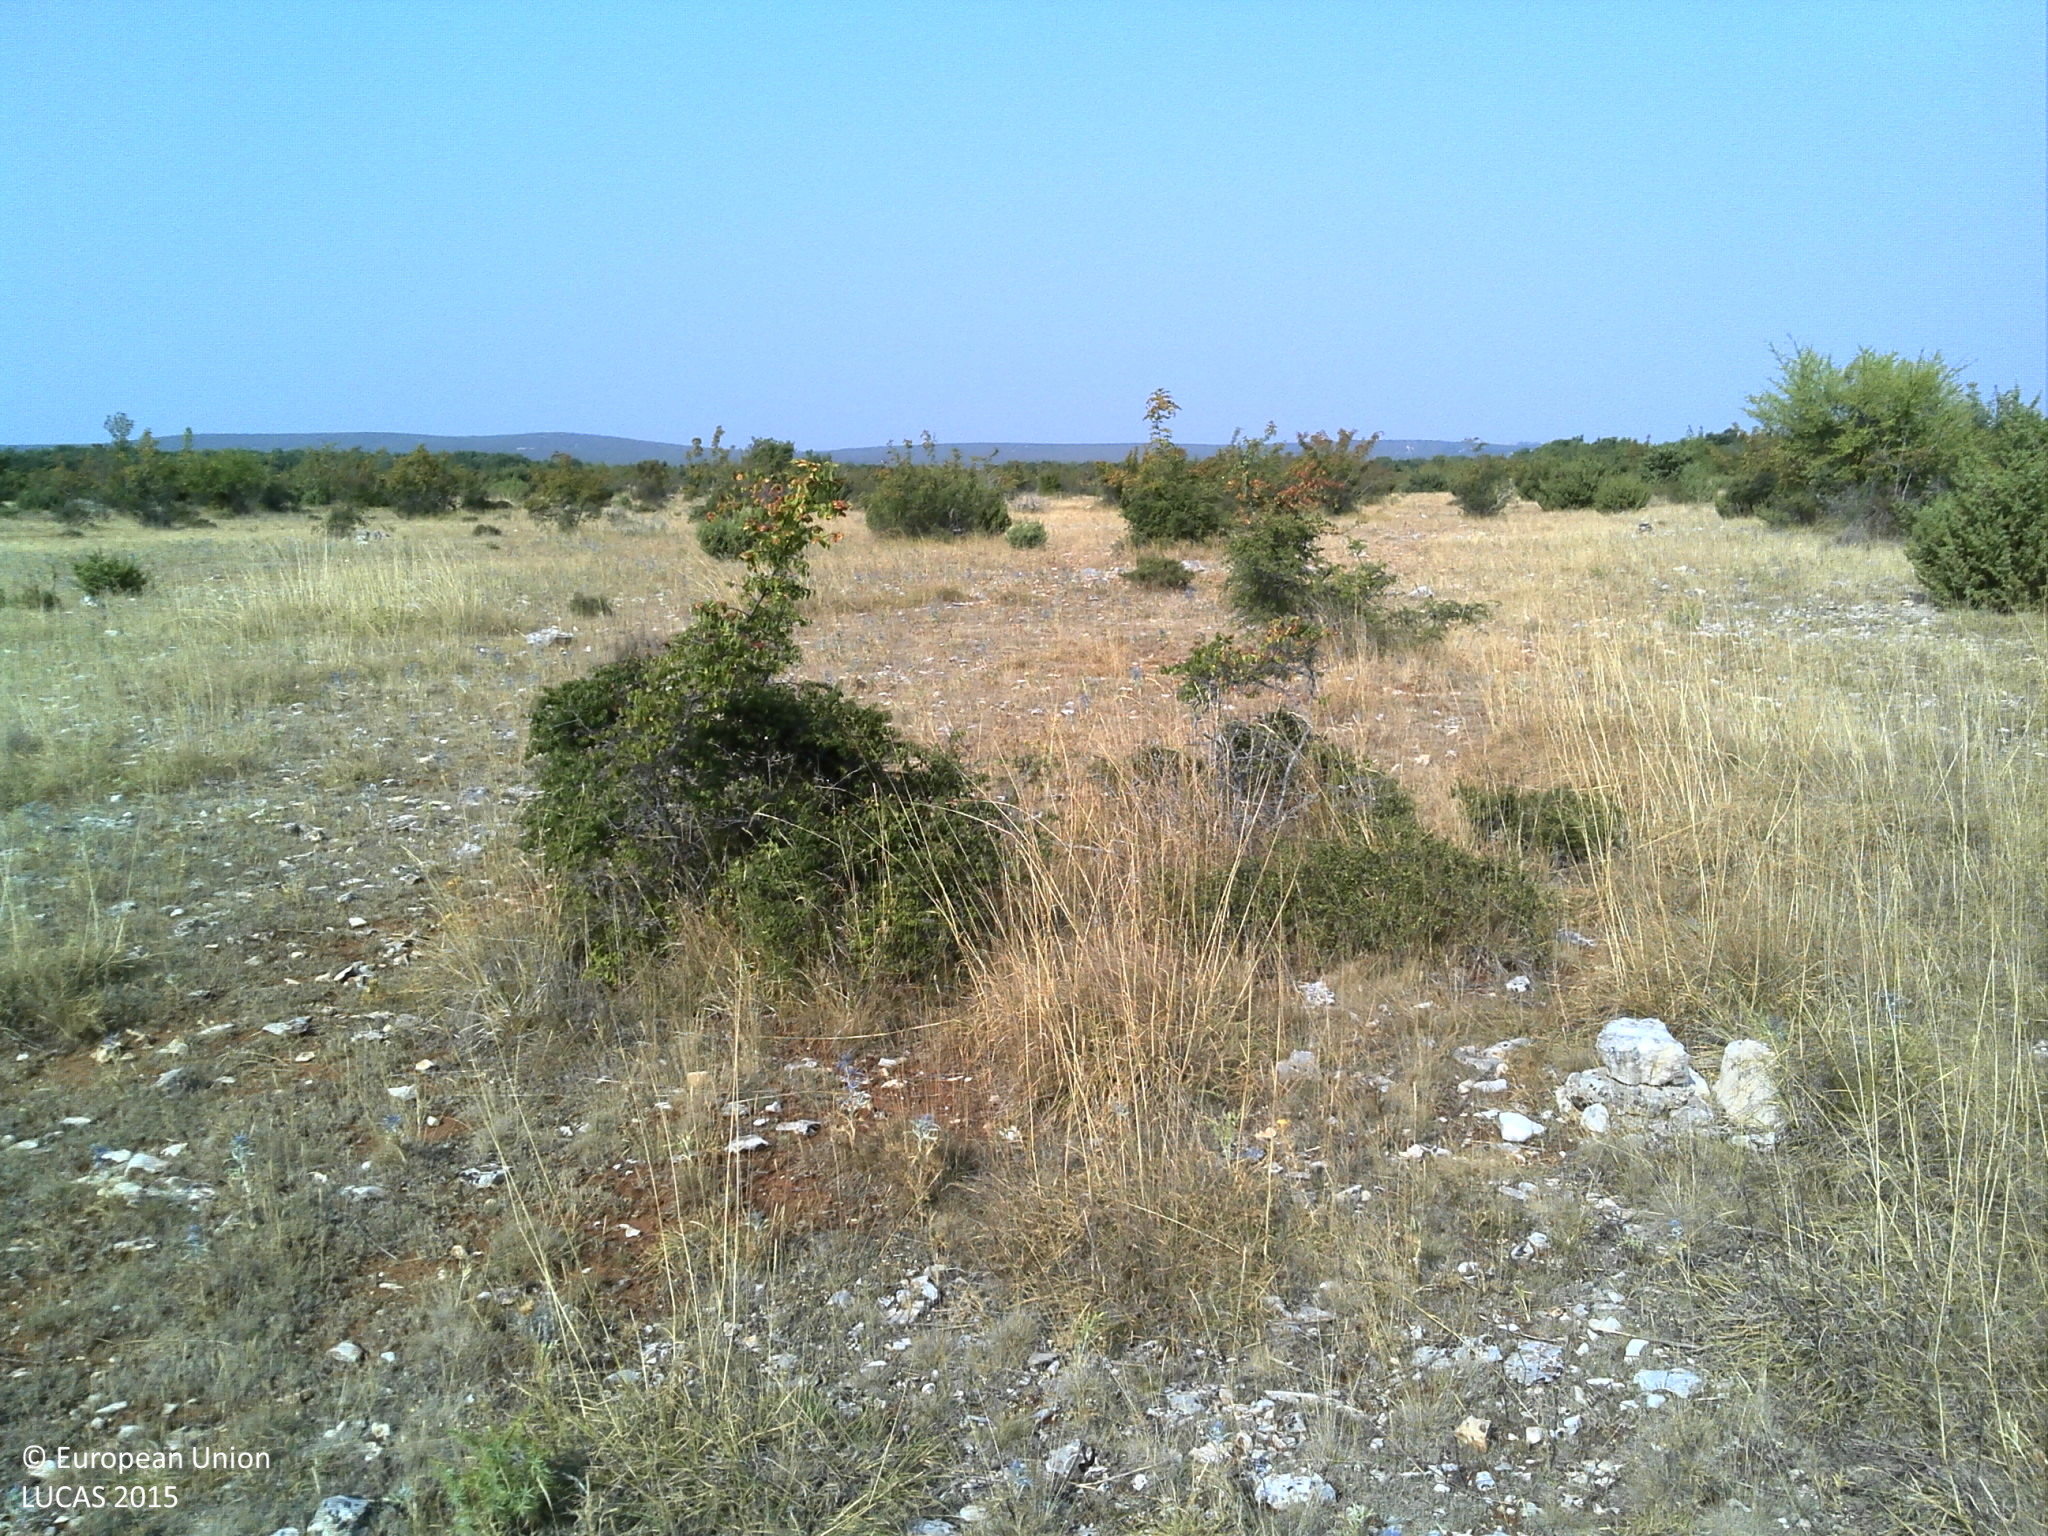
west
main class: Grassland
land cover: Grassland with sparse tree/shrub cover
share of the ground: > 75 %
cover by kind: herbaceous plants 65 %, unconsolidated bare surface 20 %, shrubs 10 %, broadleaved forest trees 5 %
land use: Semi-natural and natural areas not in use
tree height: < 5 m
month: August
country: HR
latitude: 44.0189
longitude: 15.9177
